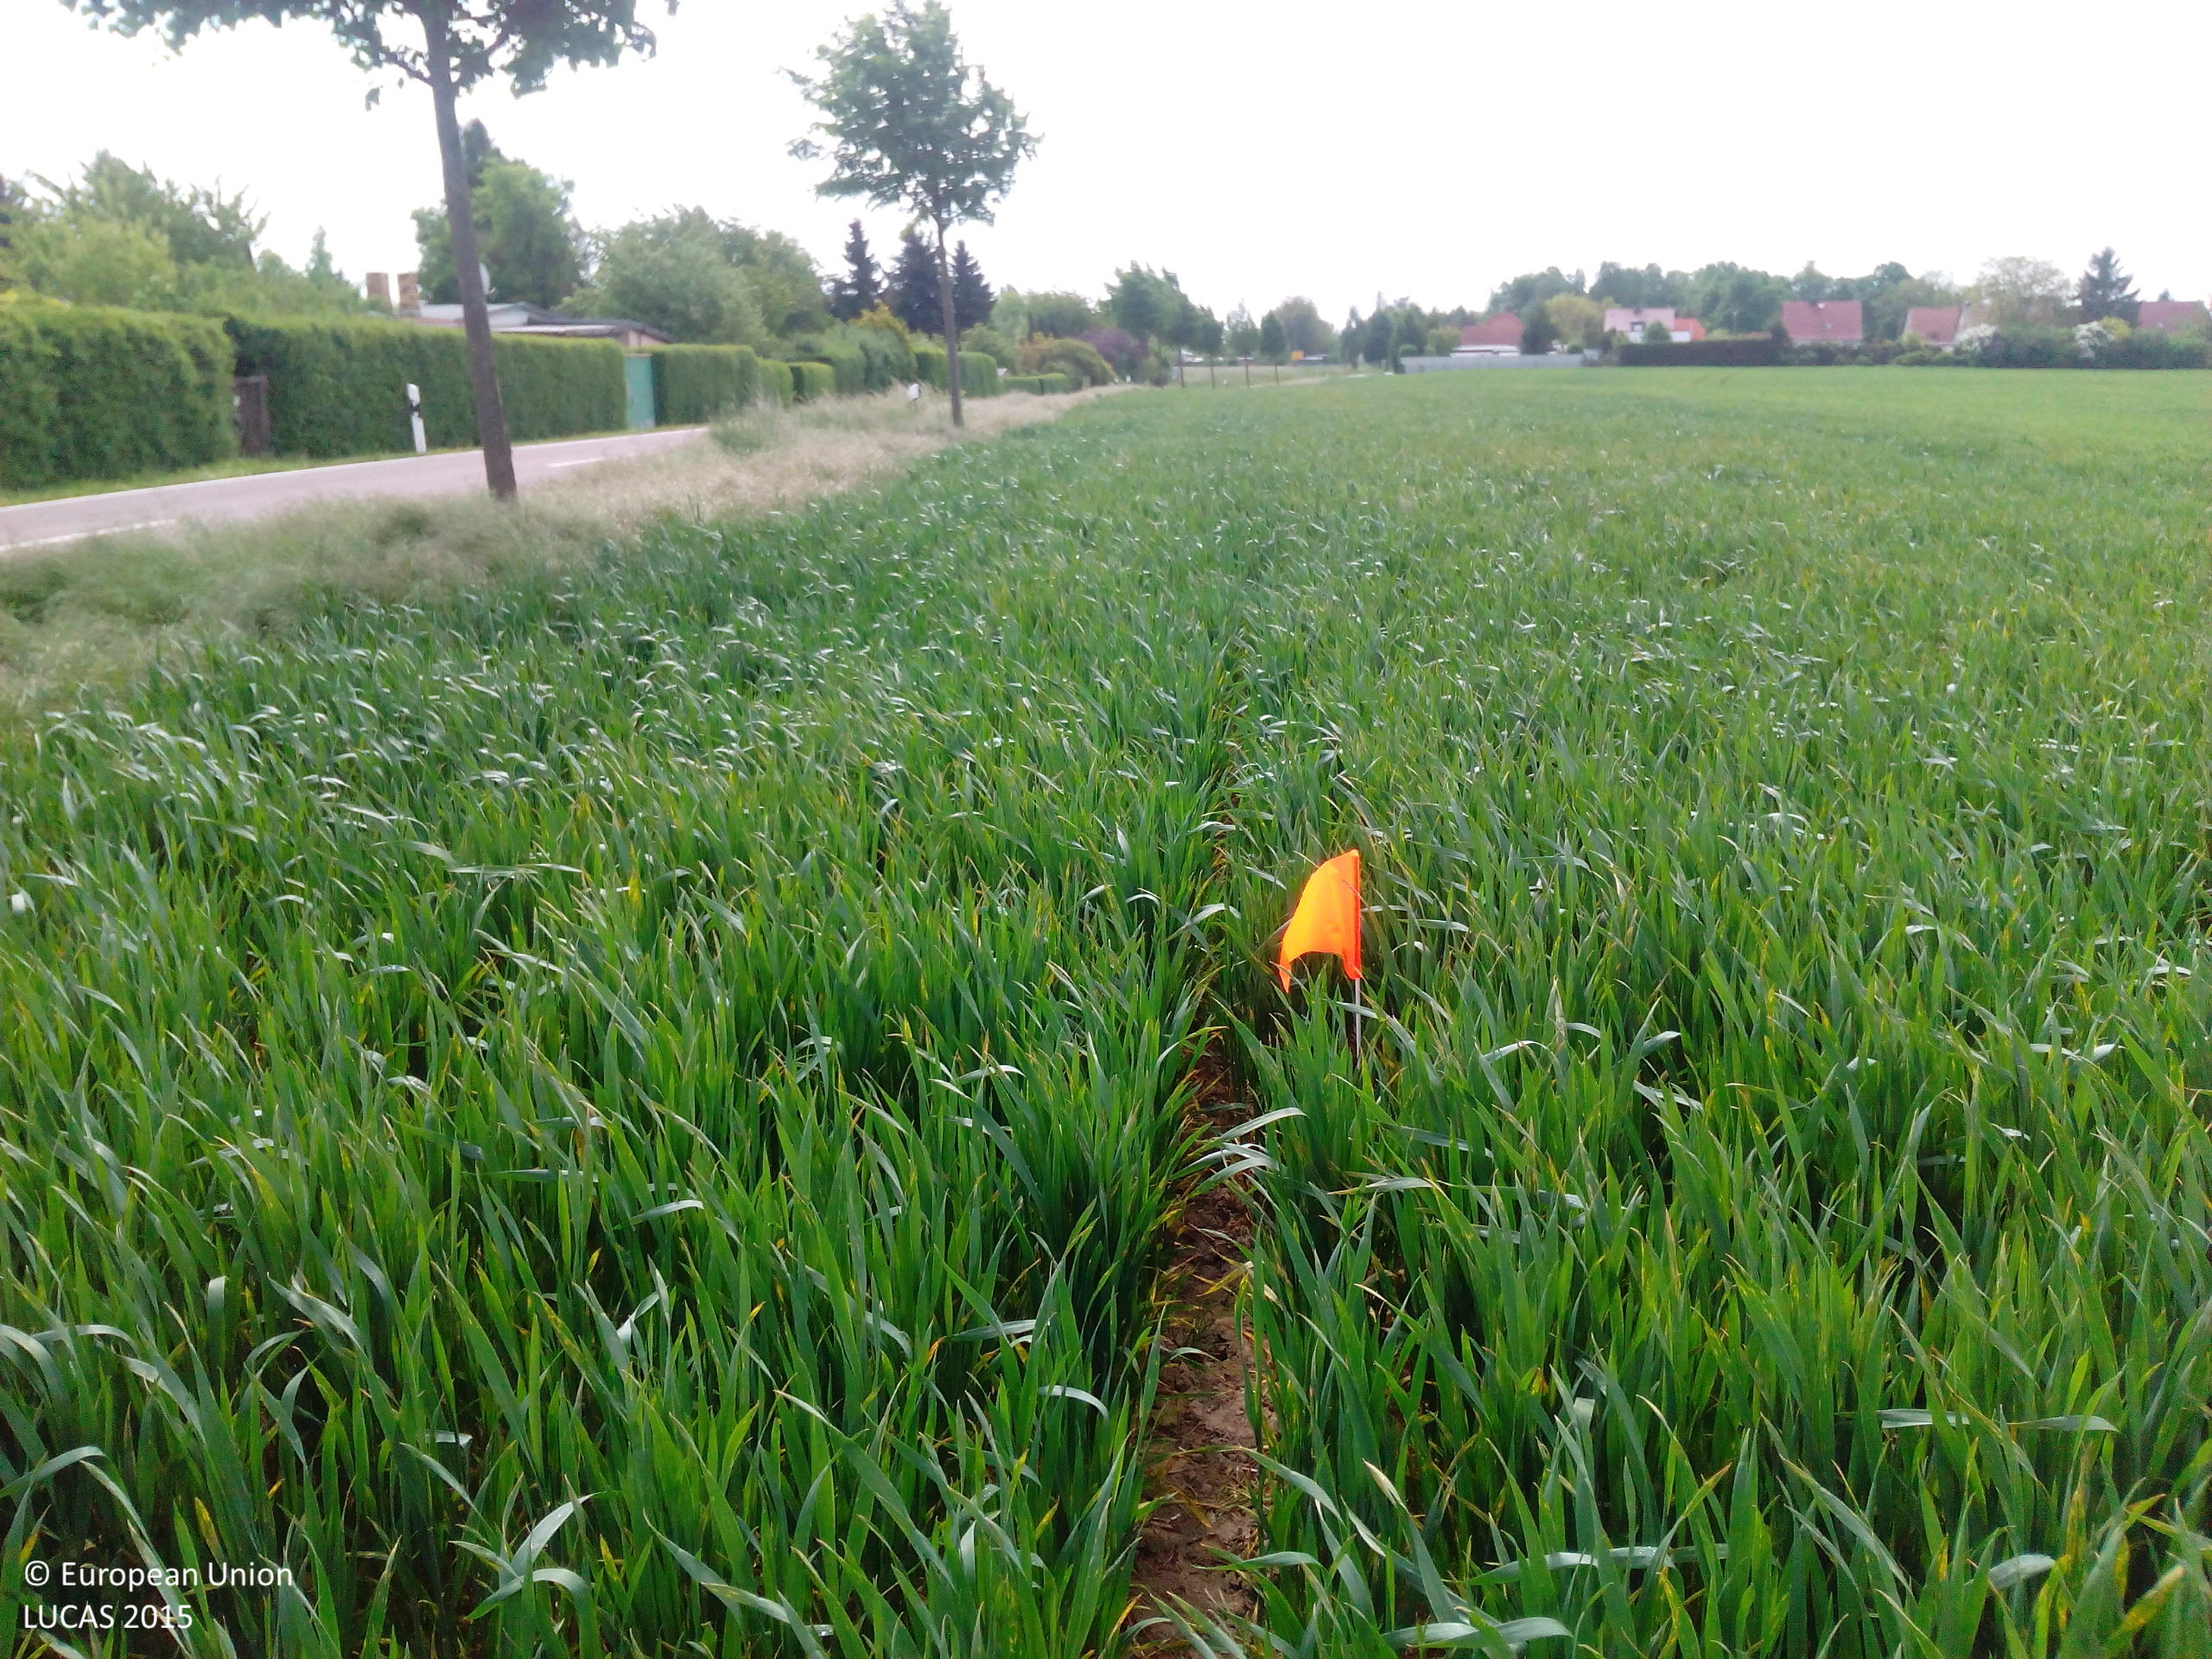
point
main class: Cropland
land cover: Common wheat
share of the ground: > 75 %
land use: Agriculture (excluding fallow land and kitchen gardens)
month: May
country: DE
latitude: 51.5658
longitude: 12.2069
